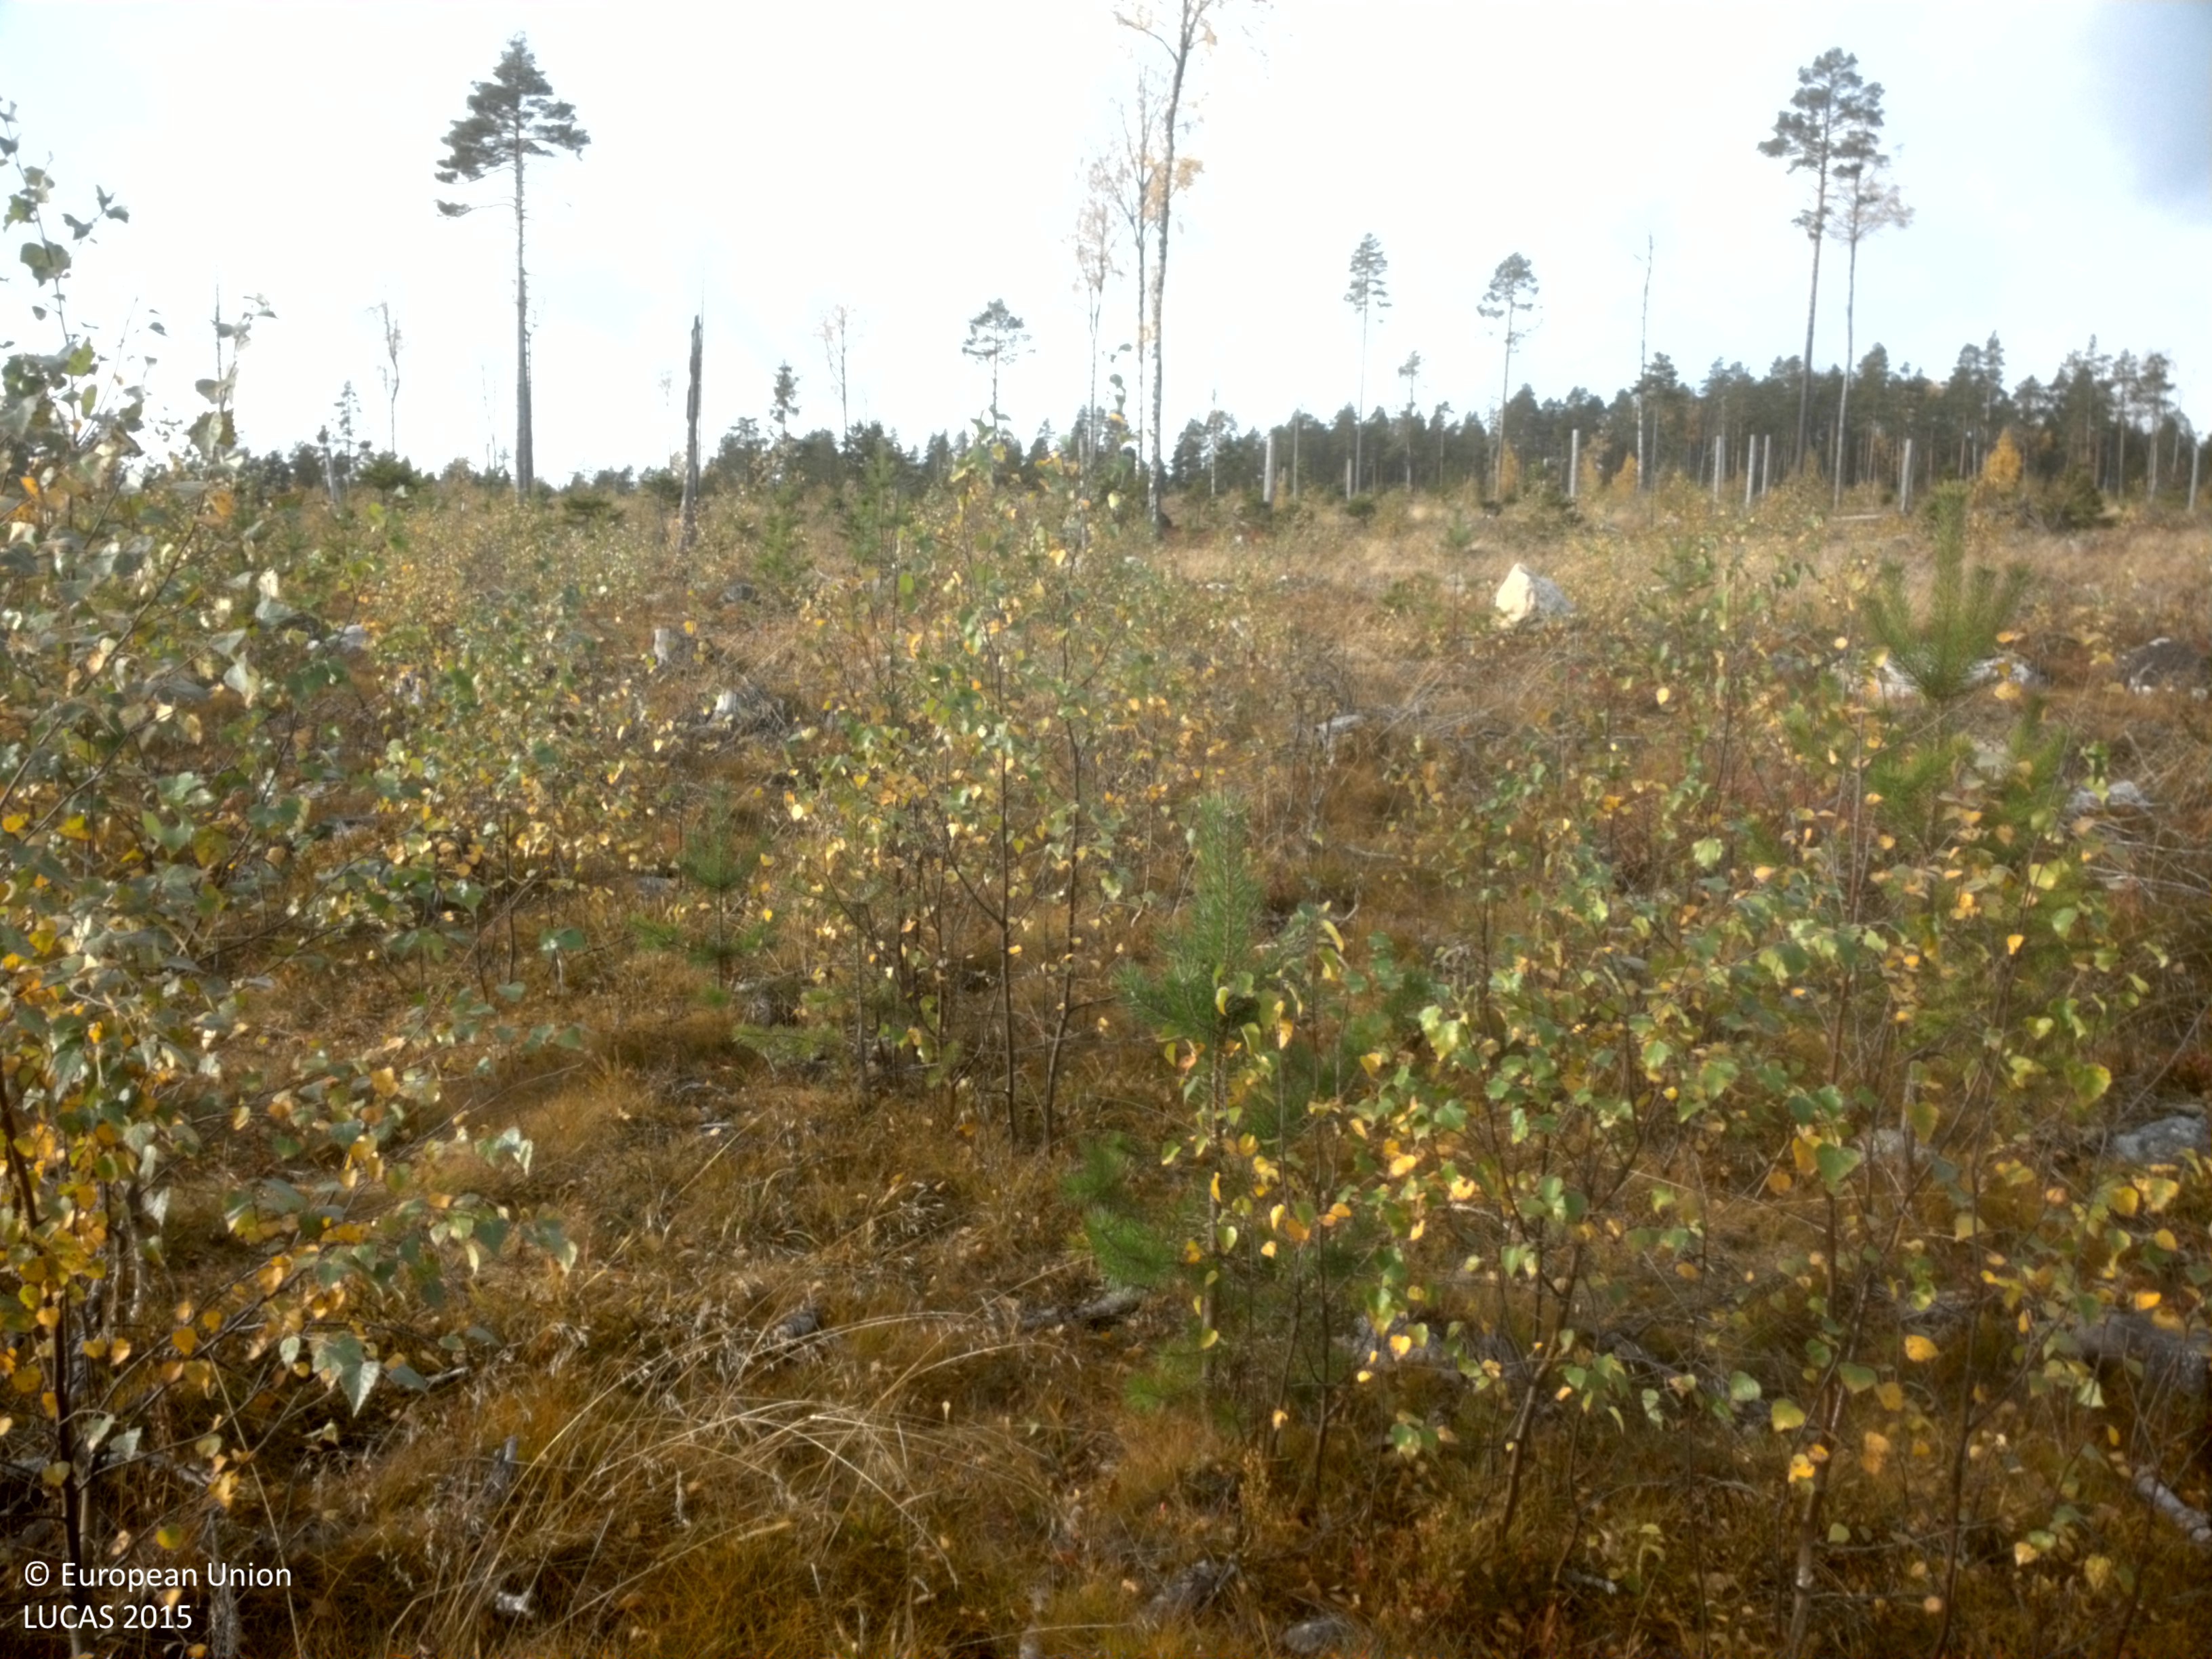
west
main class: Woodland
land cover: Broadleaved woodland
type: boreal forest
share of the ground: 50 - 75 %
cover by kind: broadleaved forest trees 45 %, herbaceous plants 40 %, shrubs 10 %, coniferous forest trees 5 %
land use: Forestry
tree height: < 5 m
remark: Clear cut
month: October
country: SE
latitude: 64.0560
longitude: 20.1198
